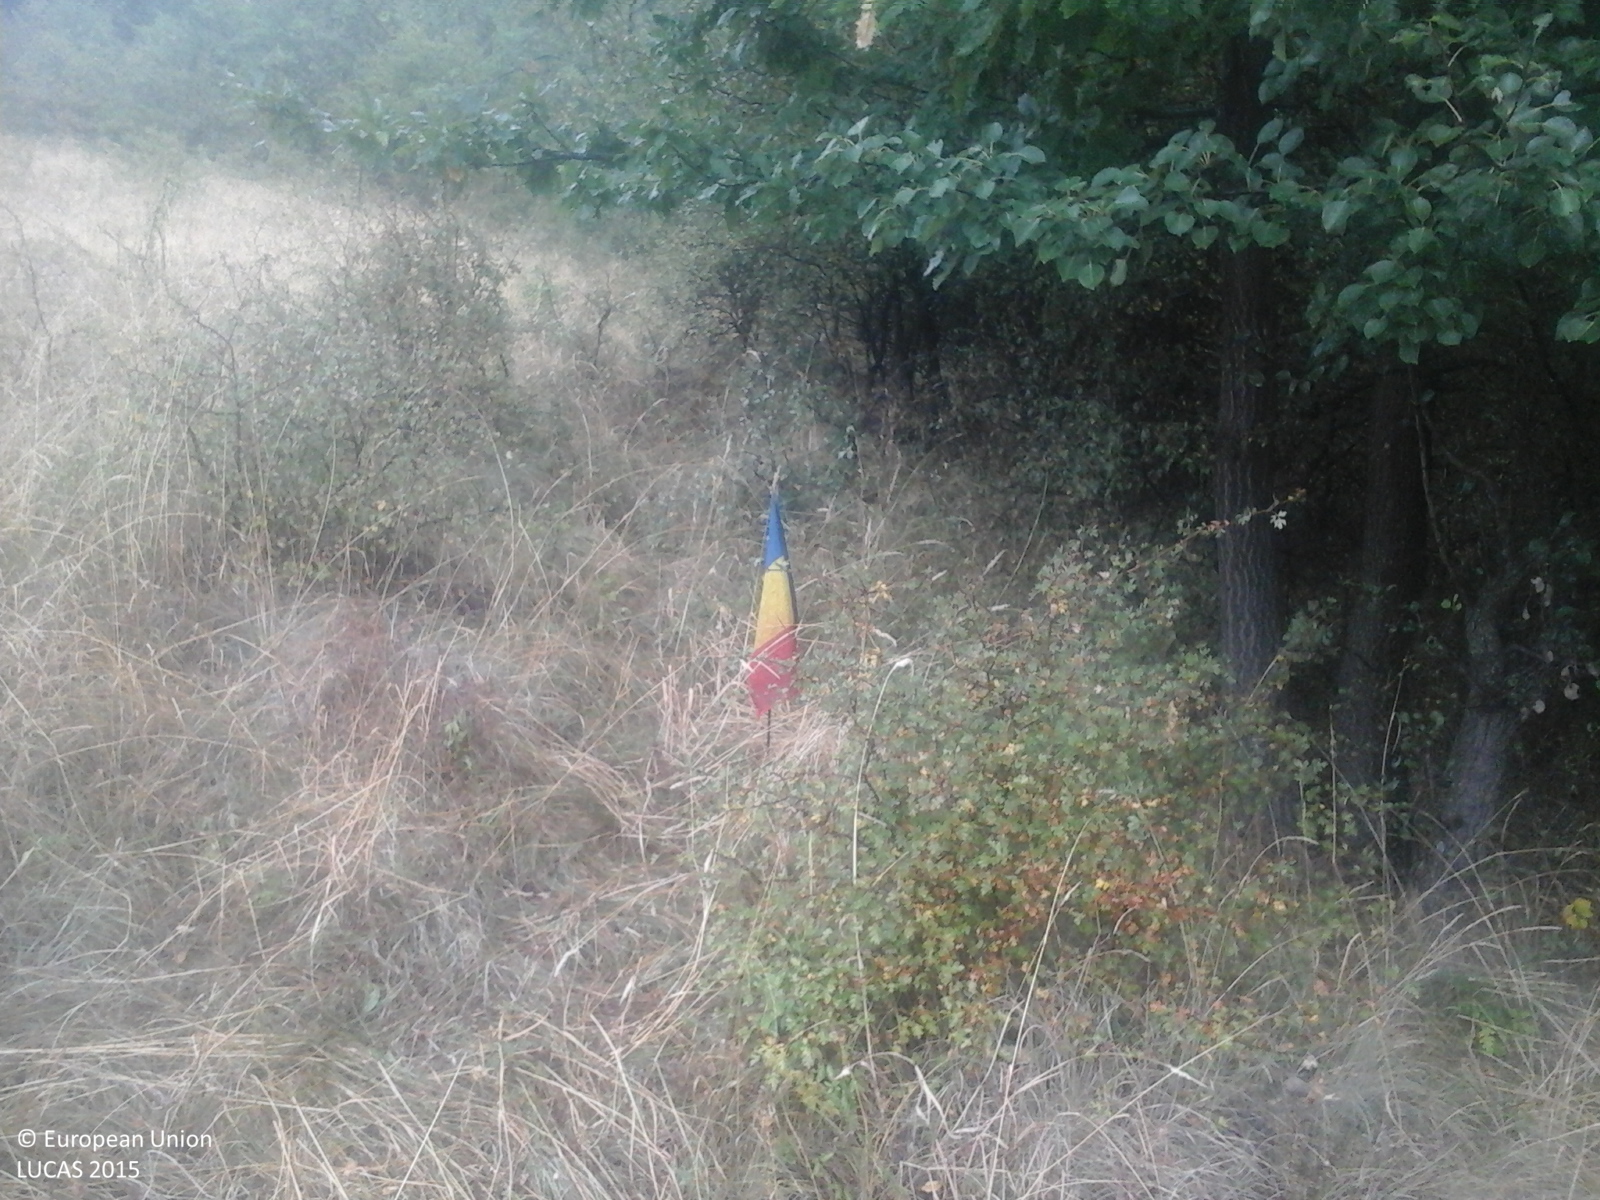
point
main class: Woodland
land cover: Broadleaved woodland
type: acidophilous oak and oak-birch forest
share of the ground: > 75 %
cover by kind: broadleaved forest trees 100 %
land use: Forestry
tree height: > 5 m
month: August
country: RO
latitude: 44.6882
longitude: 22.7748
